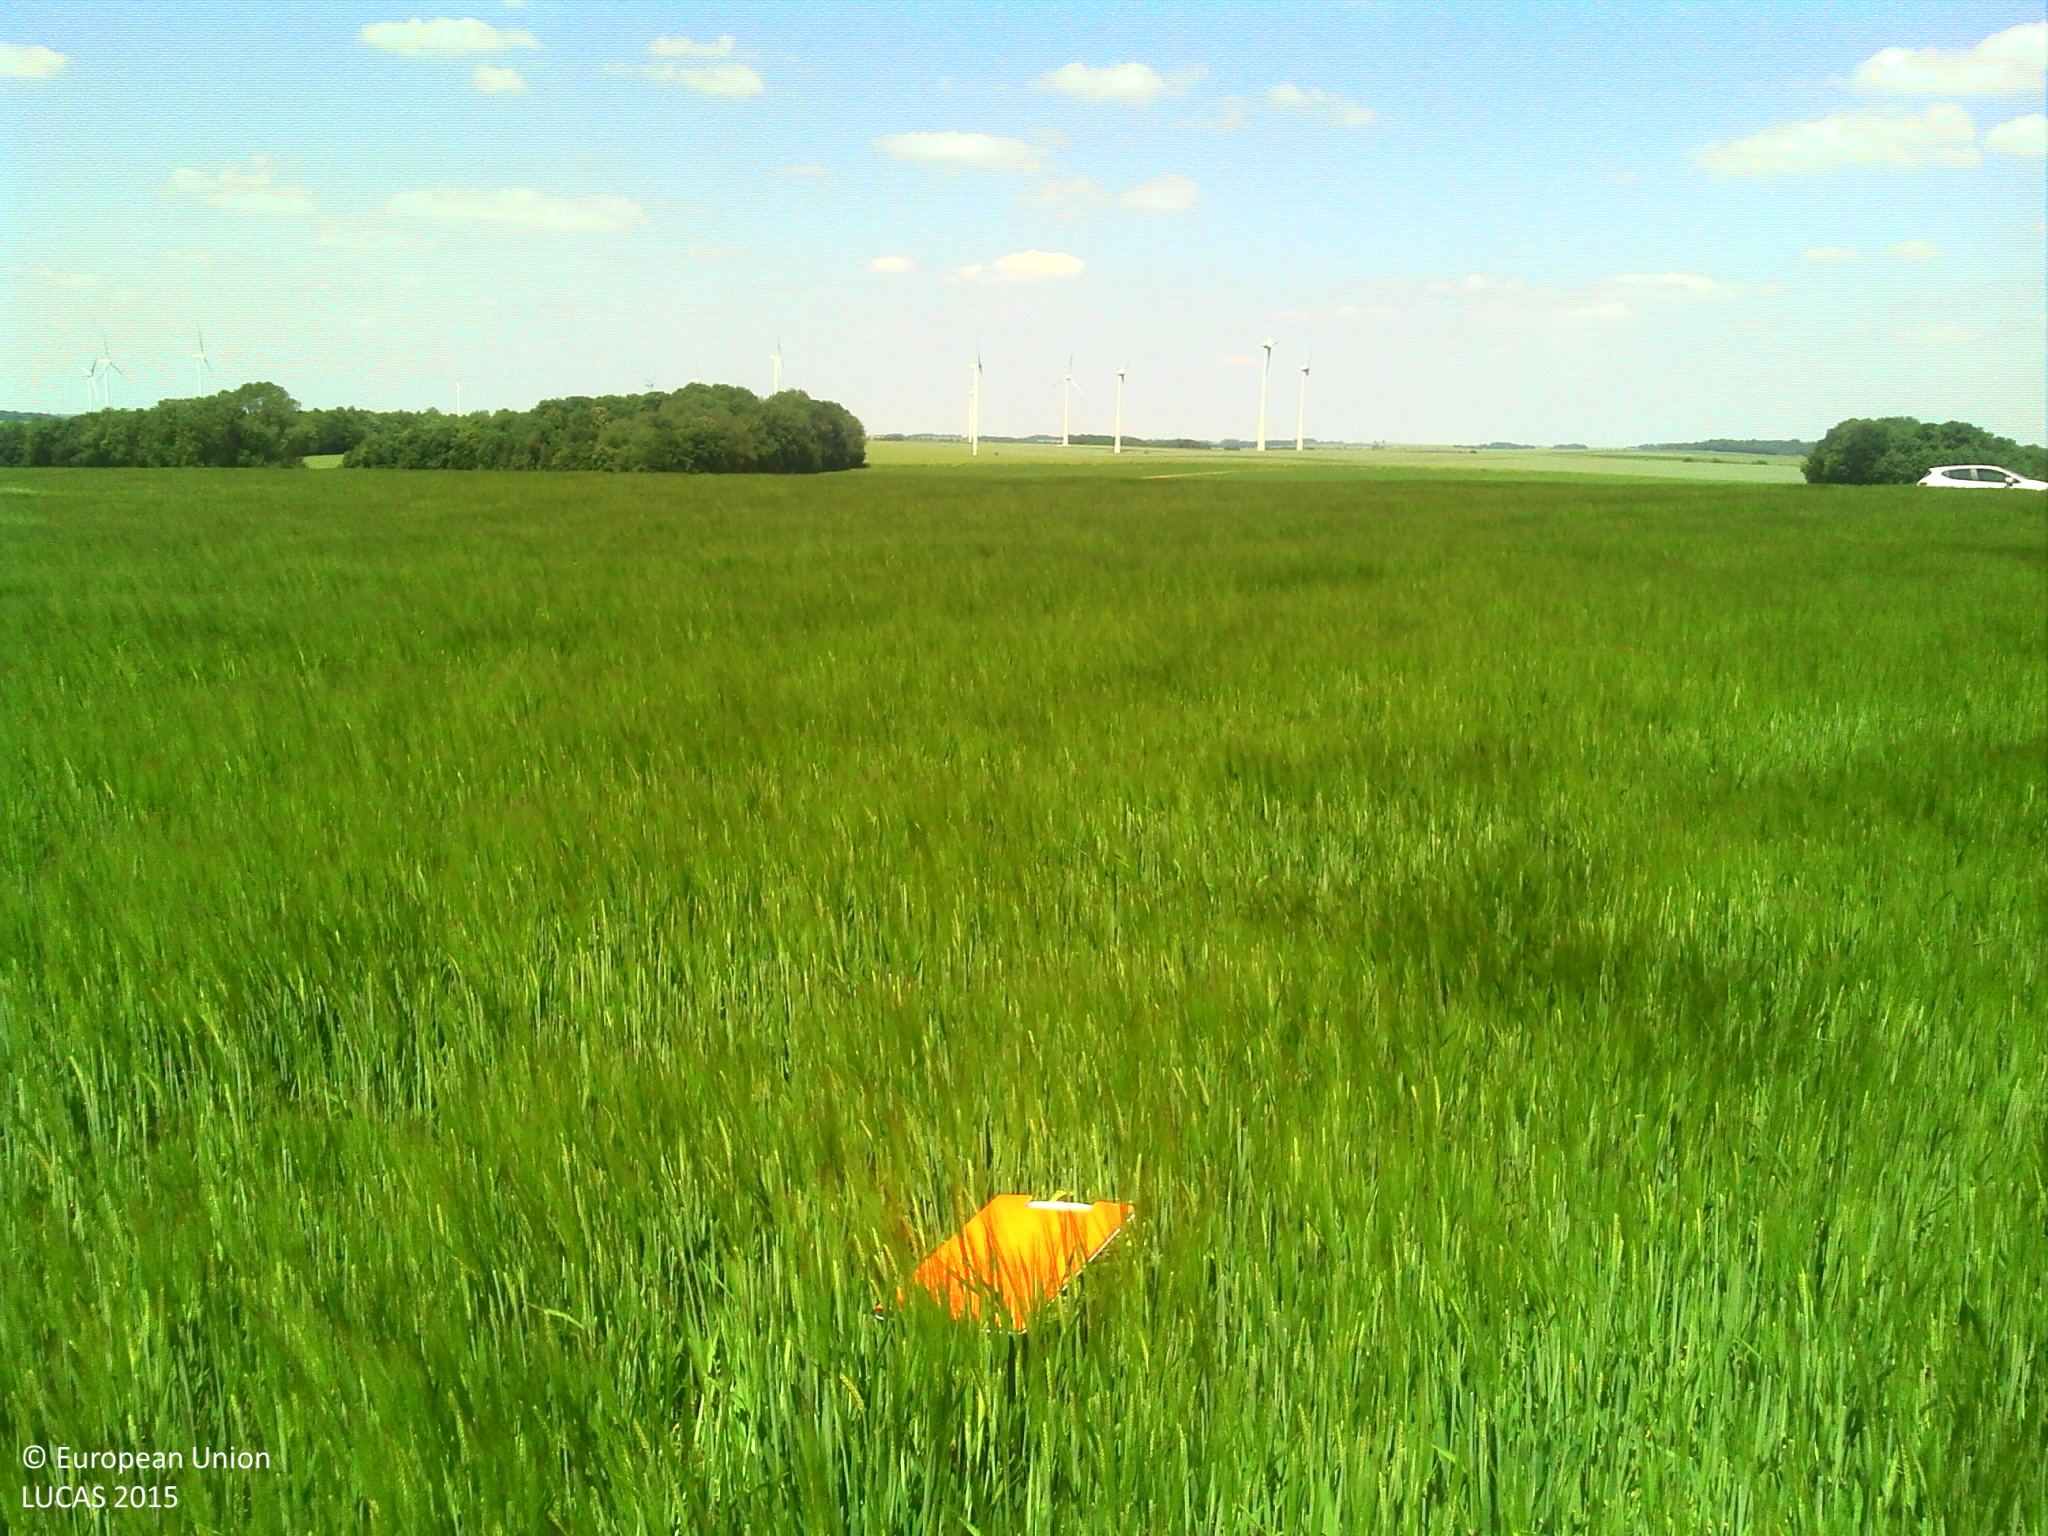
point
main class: Cropland
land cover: Rye
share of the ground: > 75 %
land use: Agriculture (excluding fallow land and kitchen gardens)
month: June
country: FR
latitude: 49.6504
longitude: 4.0529
